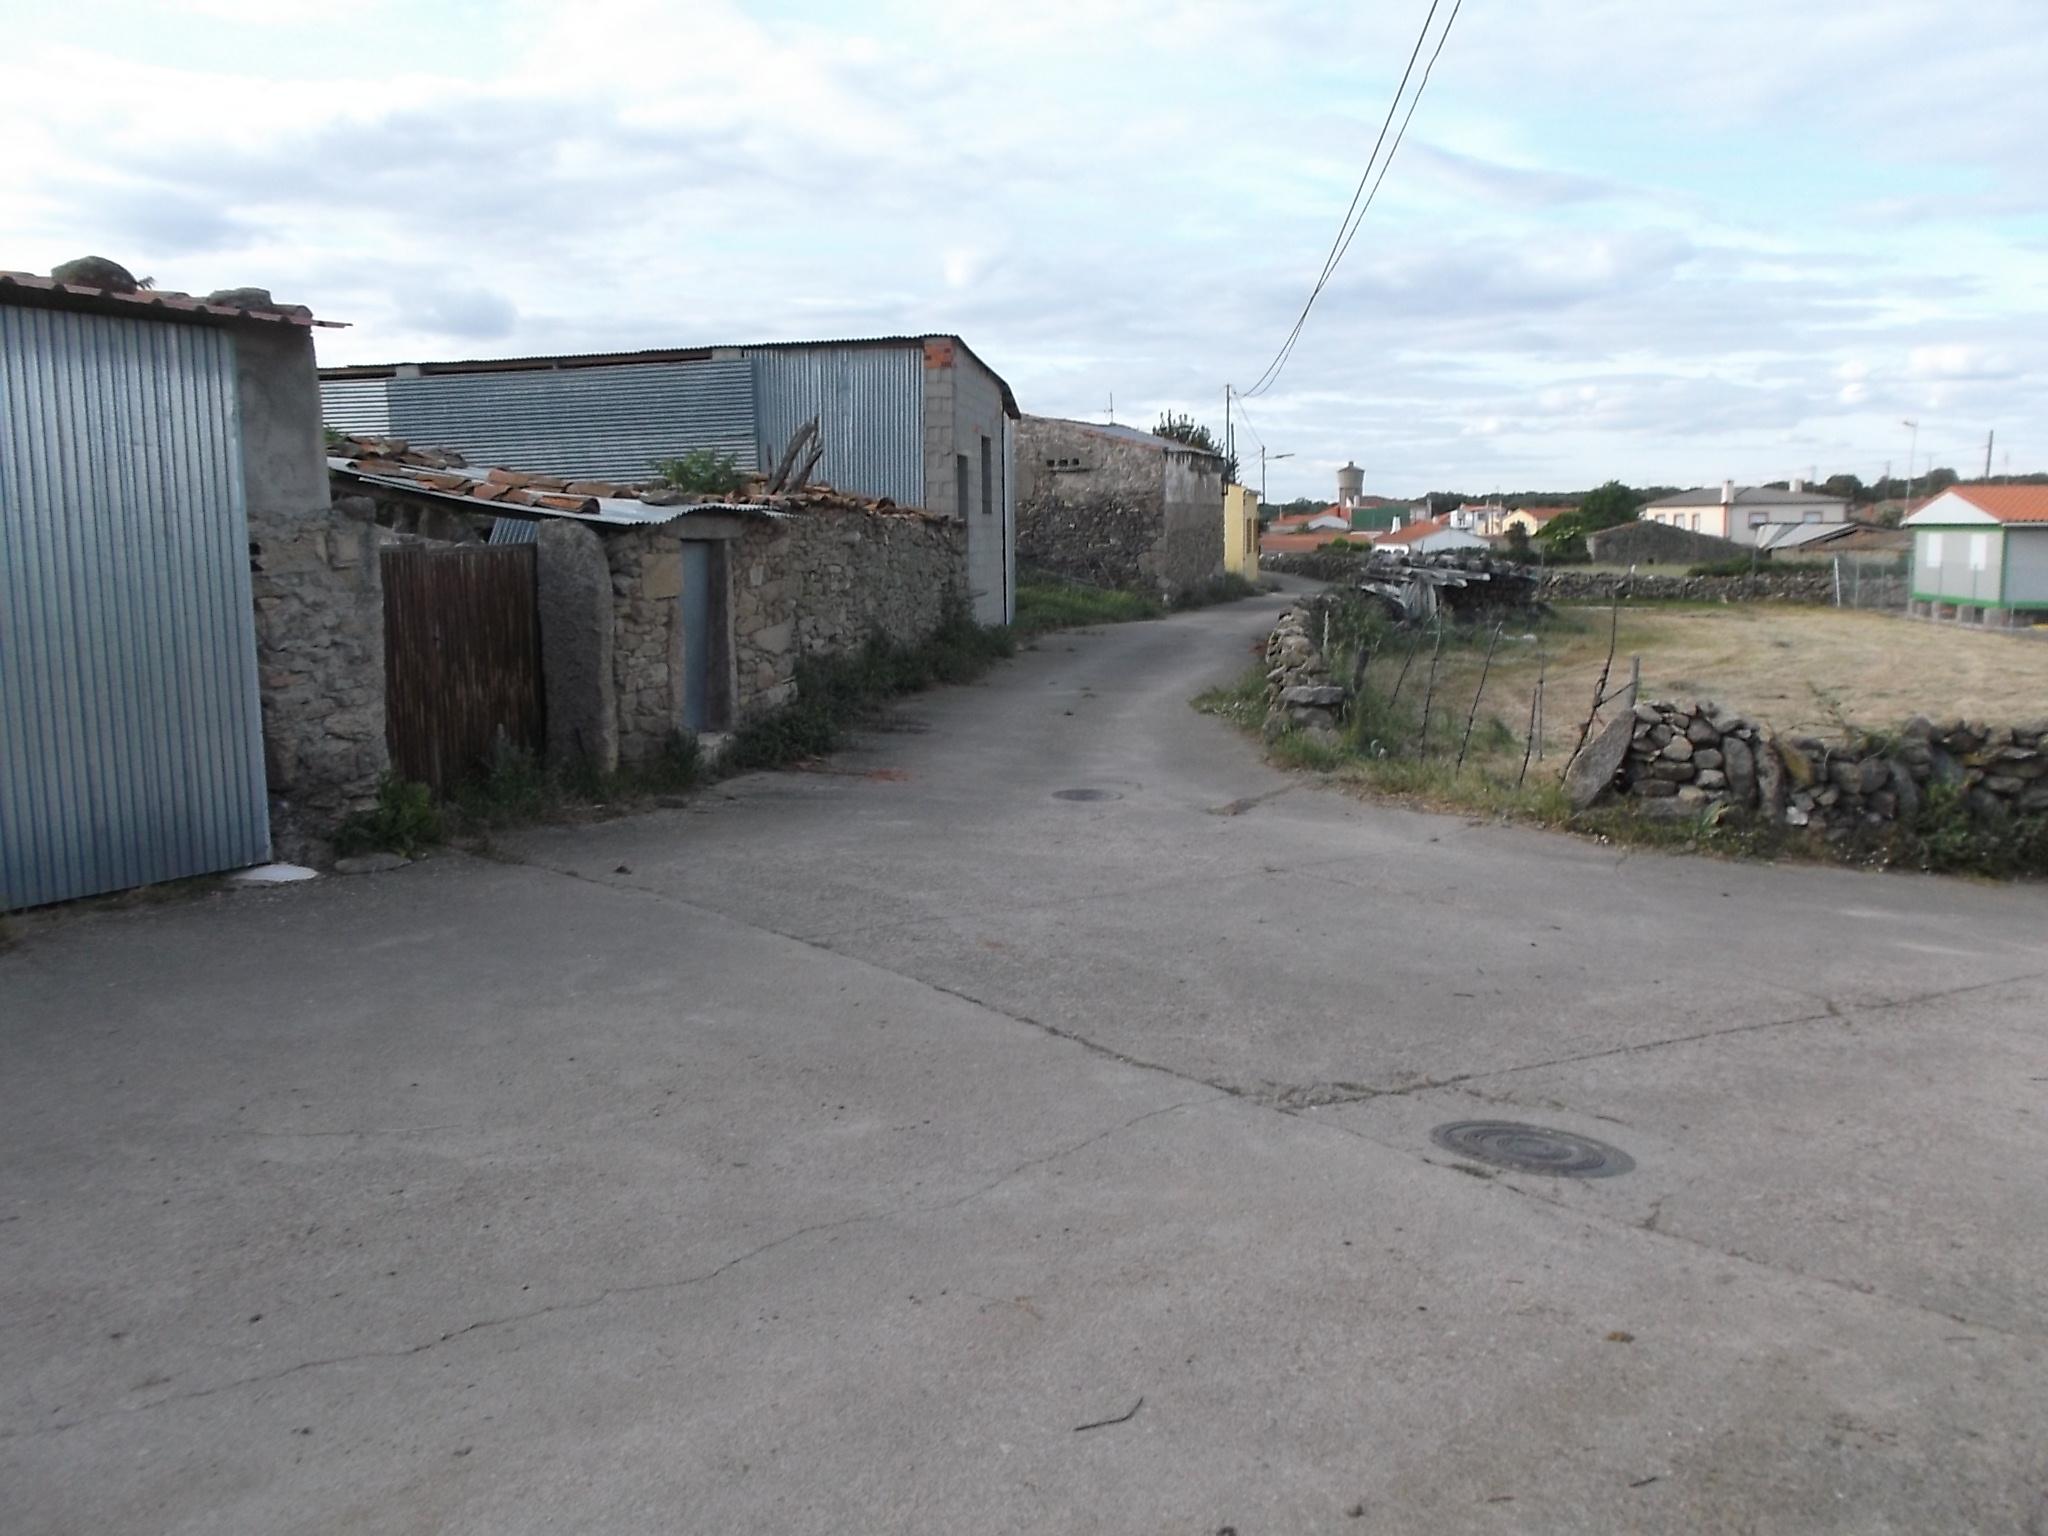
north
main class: Grassland
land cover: Grassland without tree/shrub cover
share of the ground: > 75 %
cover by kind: herbaceous plants 100 %
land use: Agriculture (excluding fallow land and kitchen gardens)
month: May
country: ES
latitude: 41.1127
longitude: -6.3491
